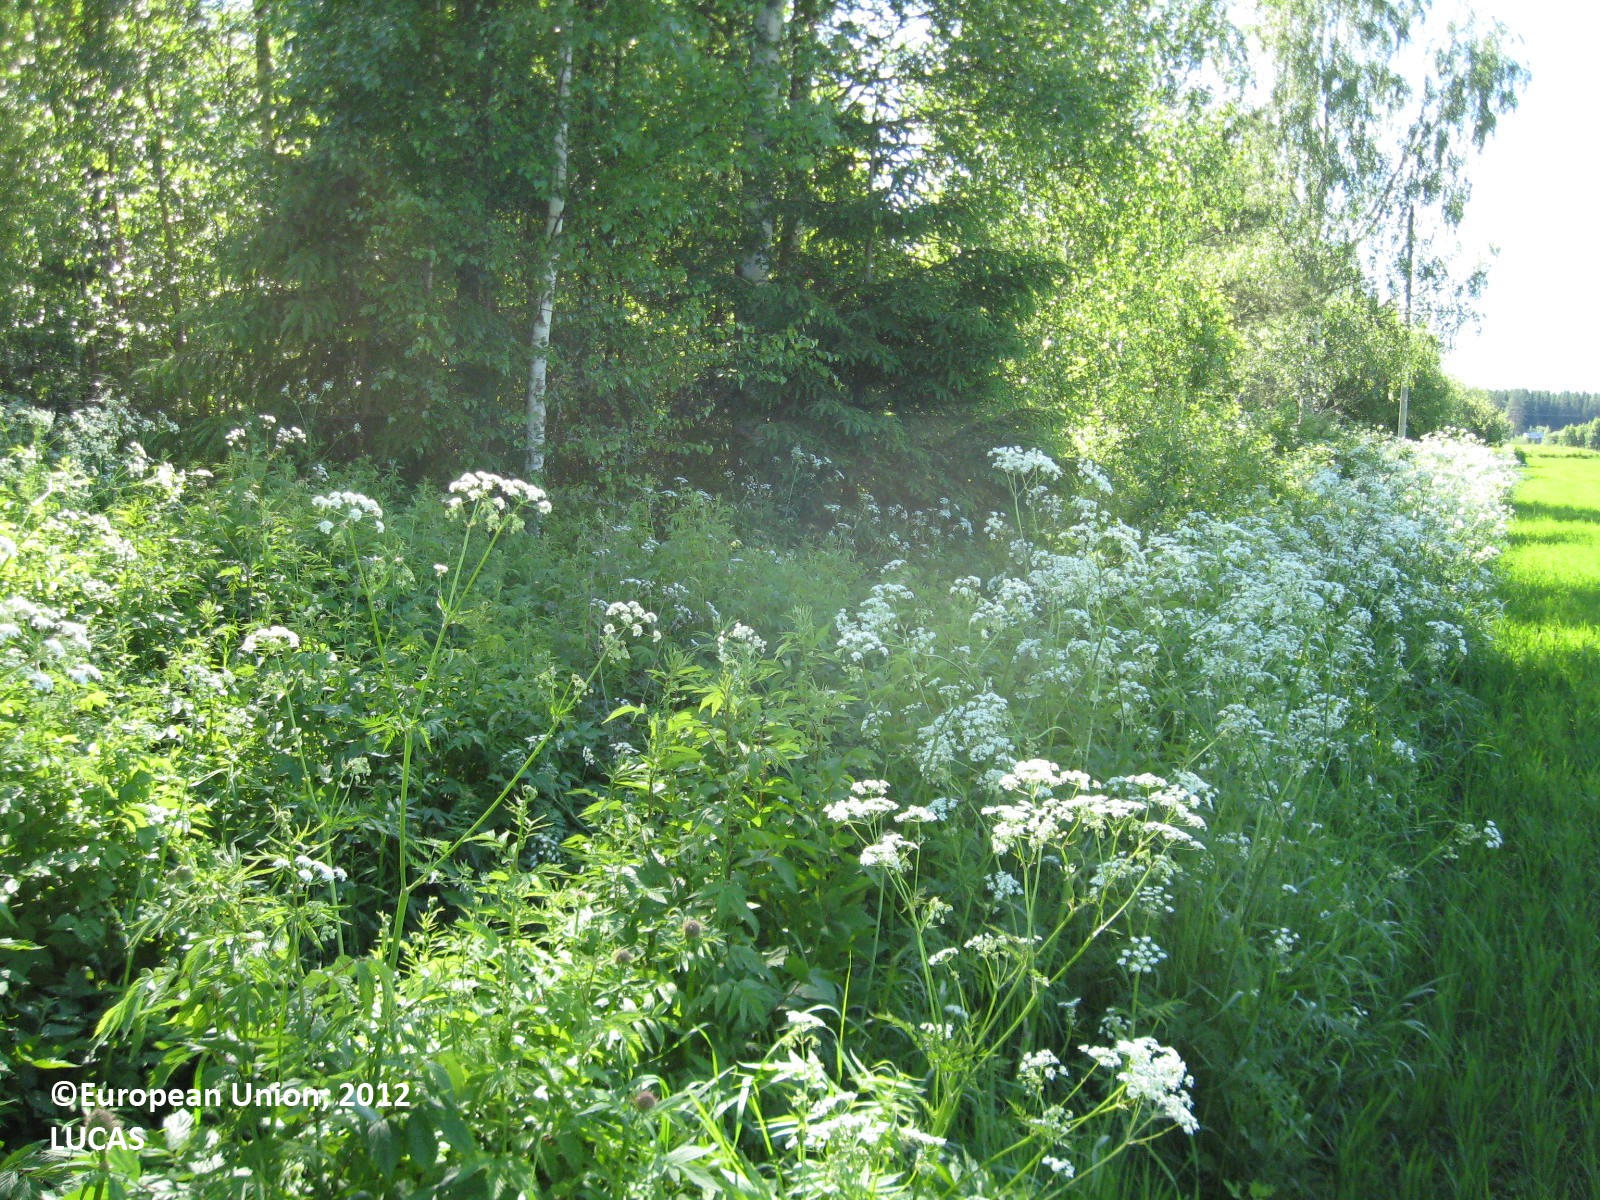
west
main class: Cropland
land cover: Common wheat
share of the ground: > 75 %
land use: Agriculture (excluding fallow land and kitchen gardens)
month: June
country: FI
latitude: 62.7933
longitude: 21.7085
